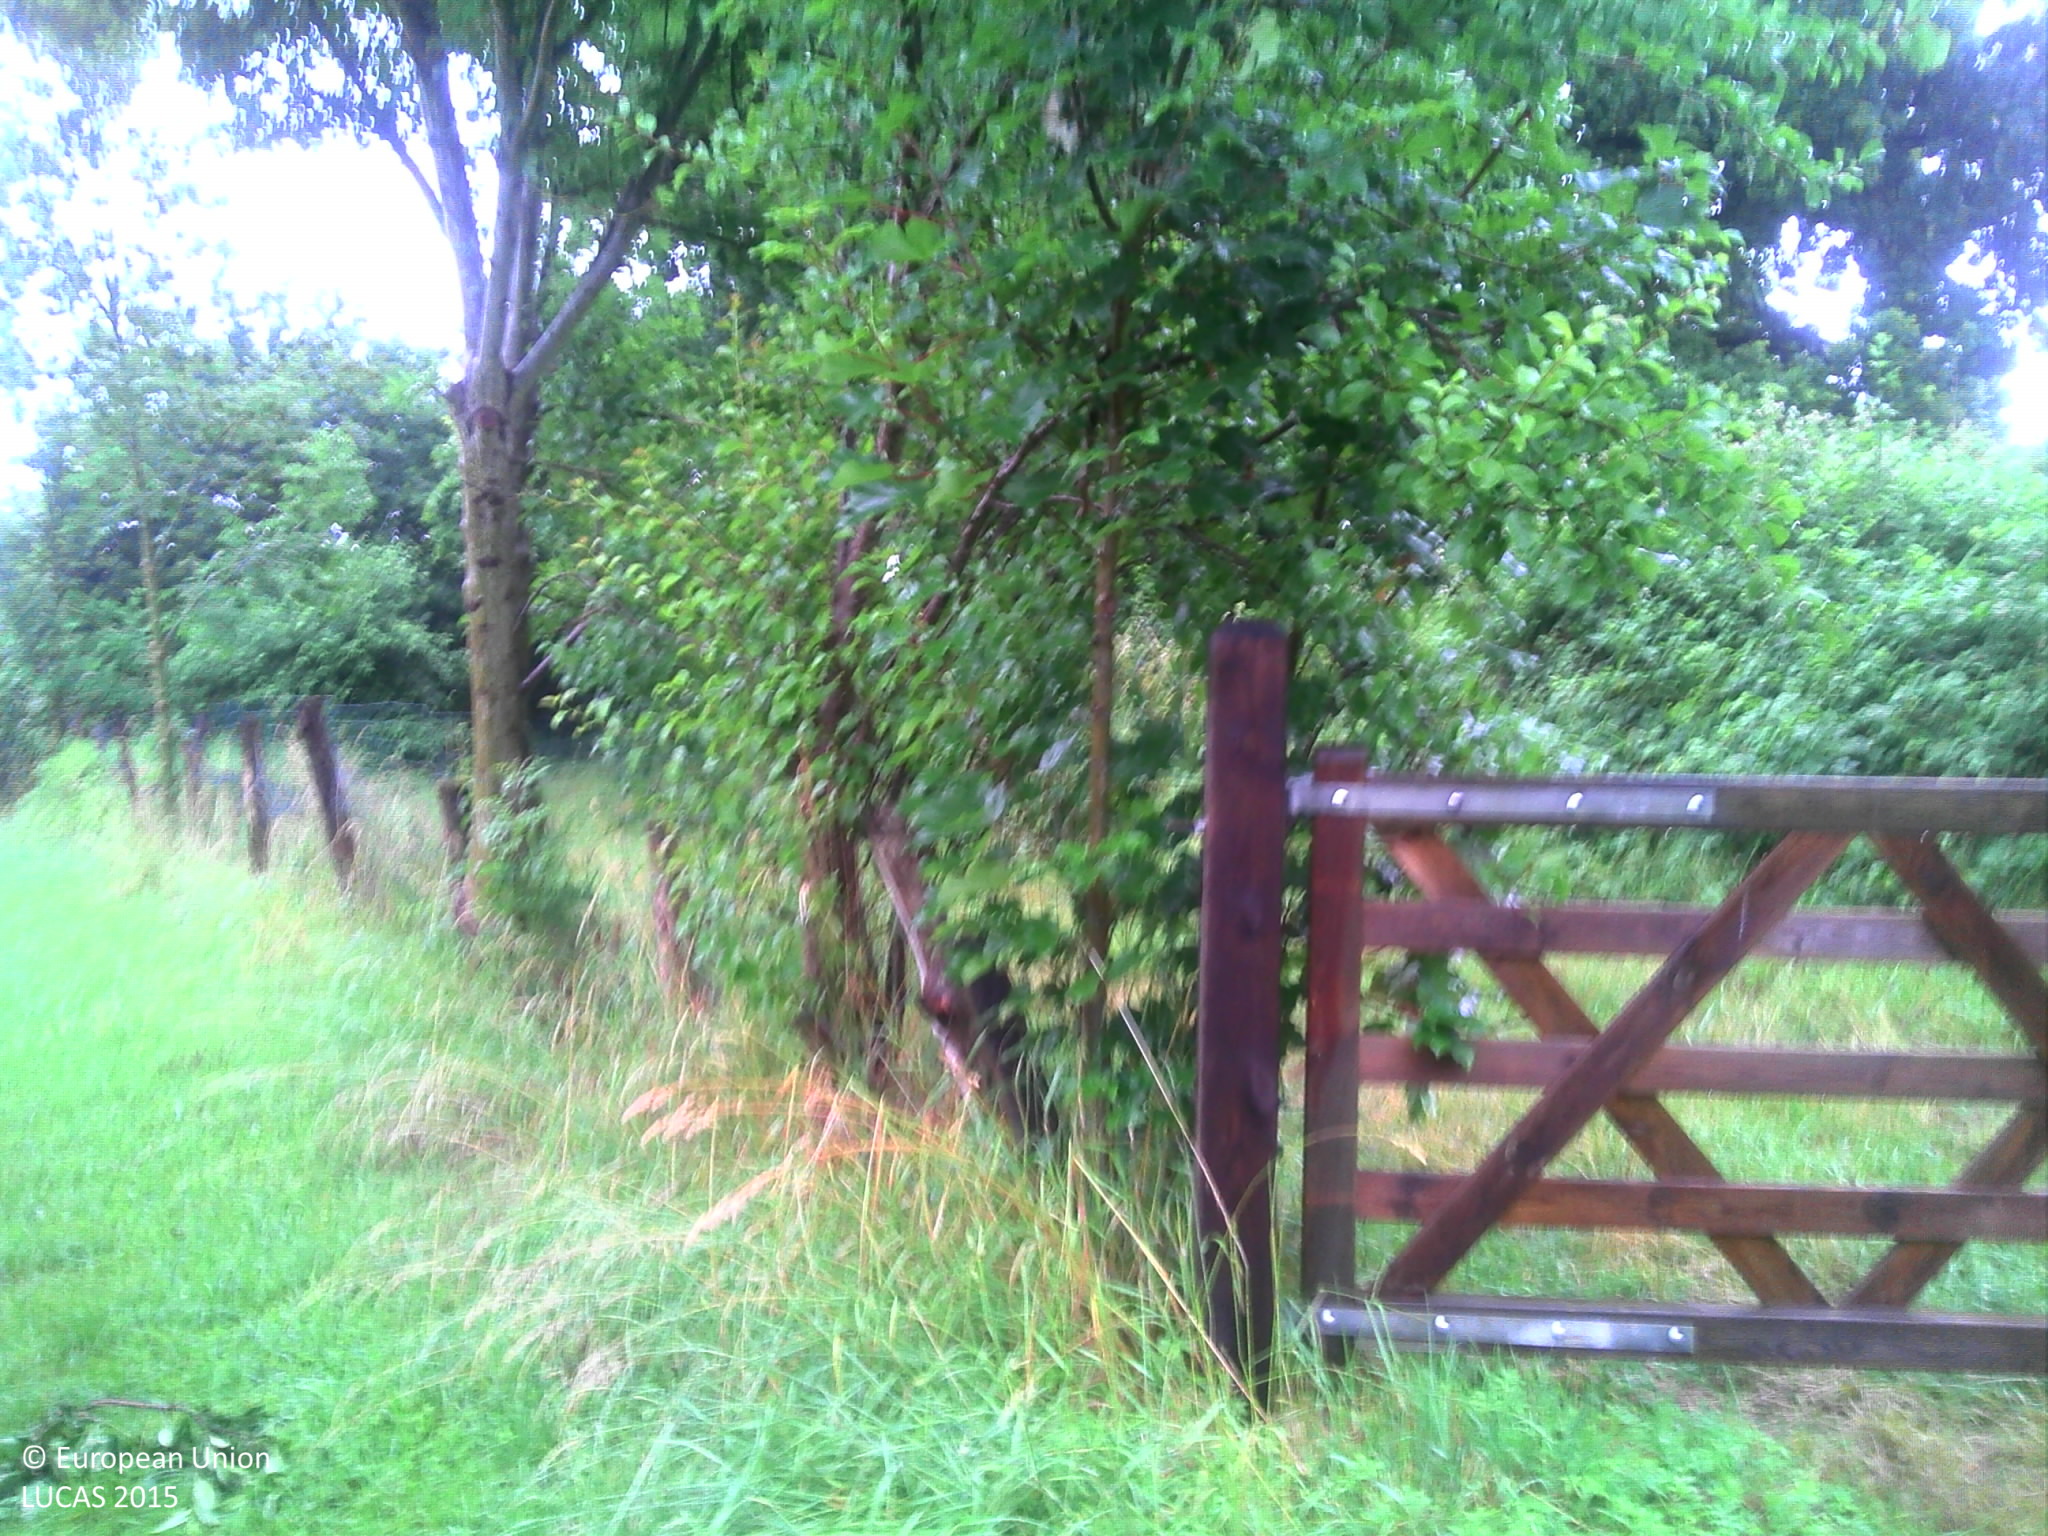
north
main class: Grassland
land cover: Grassland with sparse tree/shrub cover
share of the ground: > 75 %
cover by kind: herbaceous plants 95 %, broadleaved forest trees 5 %
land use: Agriculture (excluding fallow land and kitchen gardens)
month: June
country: FR
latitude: 47.6522
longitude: 7.3788
